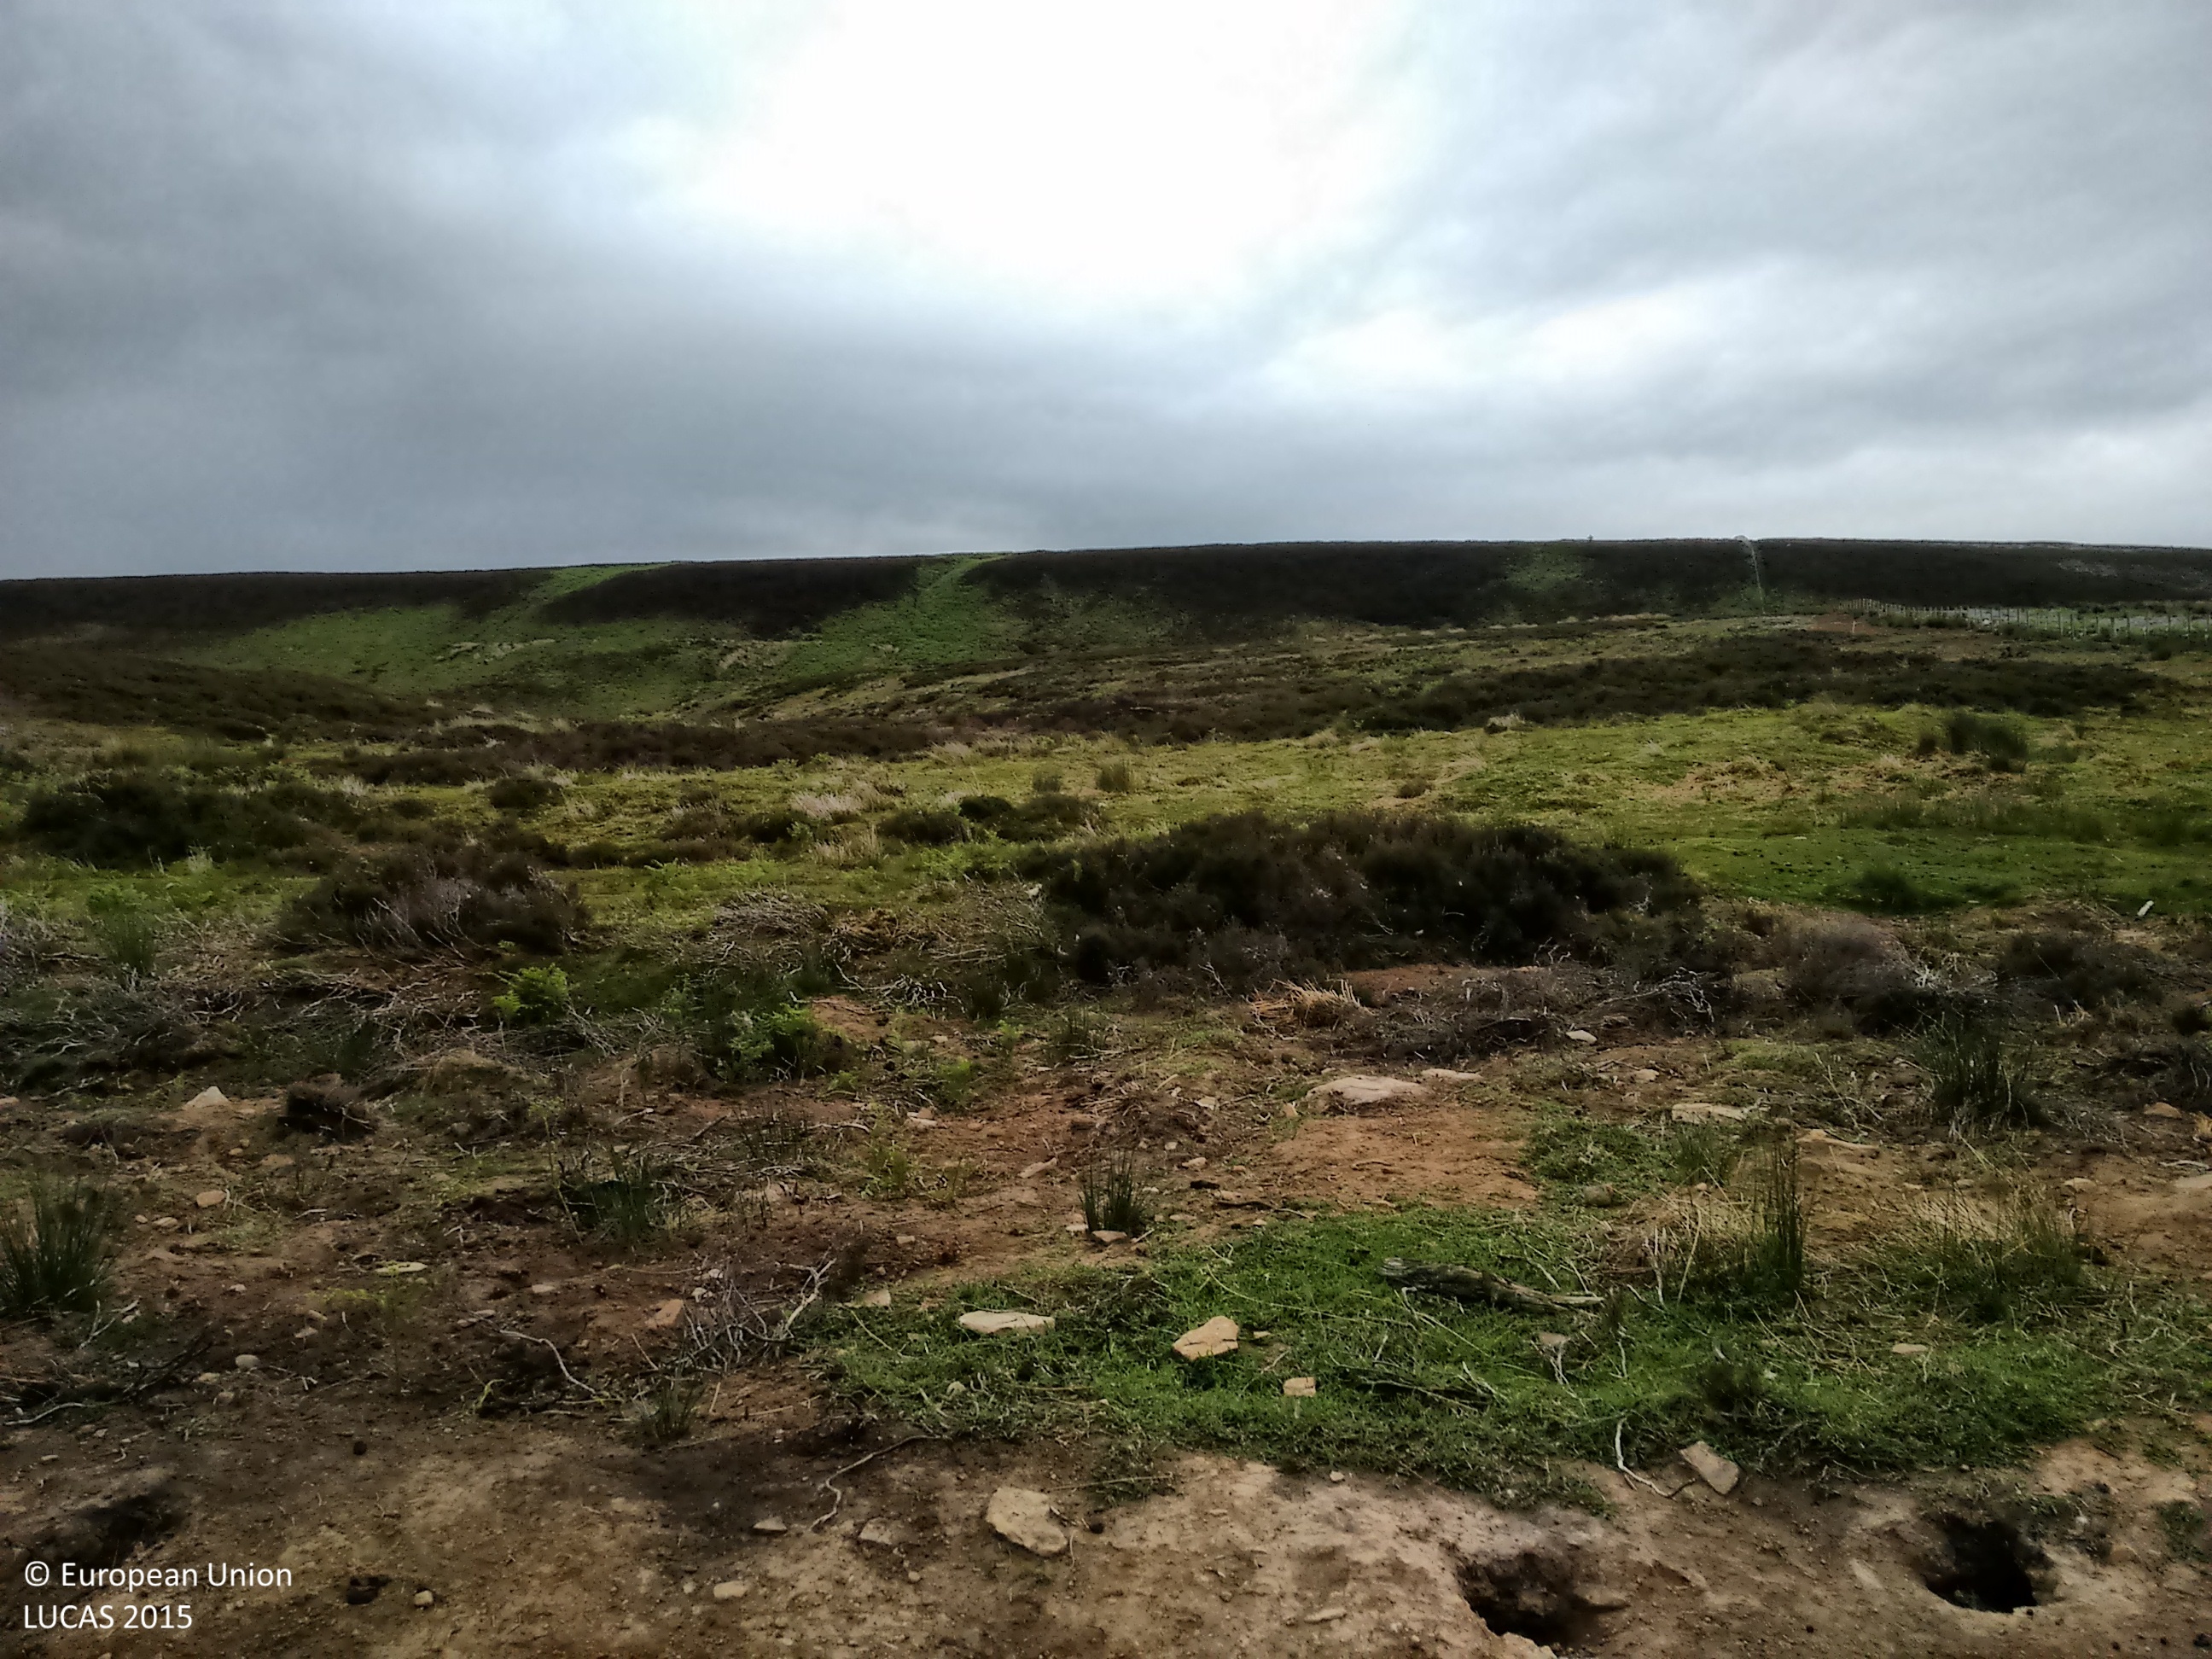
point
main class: Shrubland
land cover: Shrubland without tree cover
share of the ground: > 75 %
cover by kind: shrubs 90 %, herbaceous plants 10 %
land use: Agriculture (excluding fallow land and kitchen gardens)
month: June
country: GB
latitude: 54.8576
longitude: -2.0032
